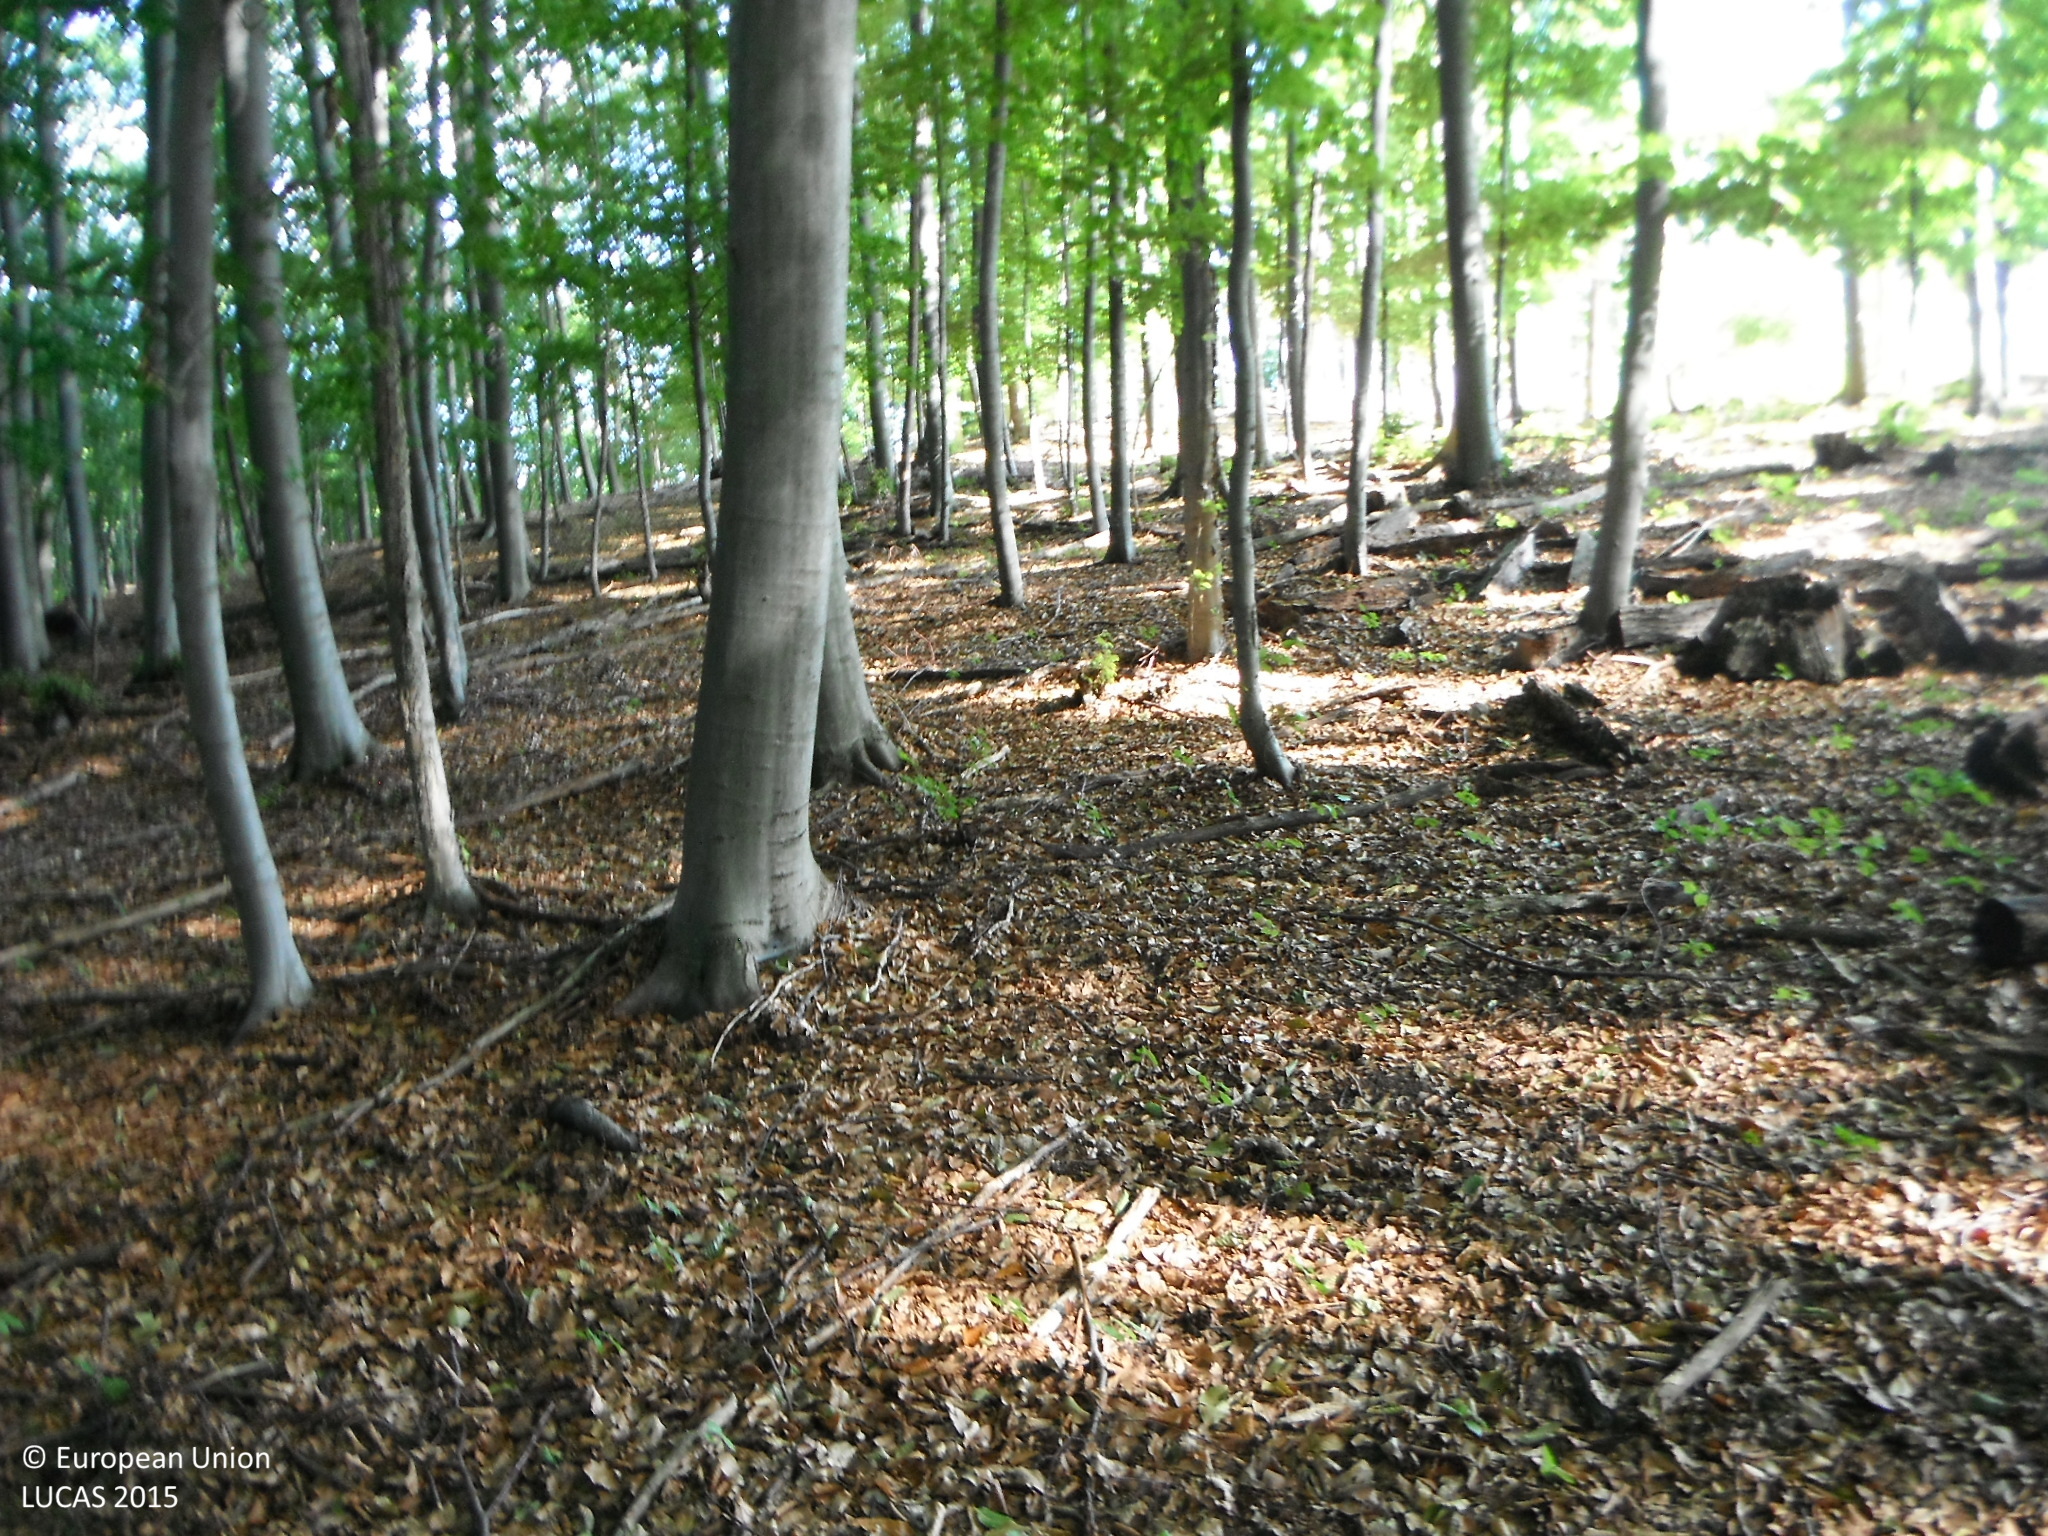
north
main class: Woodland
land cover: Broadleaved woodland
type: beech forest
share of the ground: > 75 %
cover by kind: broadleaved forest trees 90 %, consolidated bare surface 5 %
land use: Forestry
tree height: > 5 m
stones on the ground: < 10 %
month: September
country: SK
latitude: 48.7959
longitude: 18.3065
